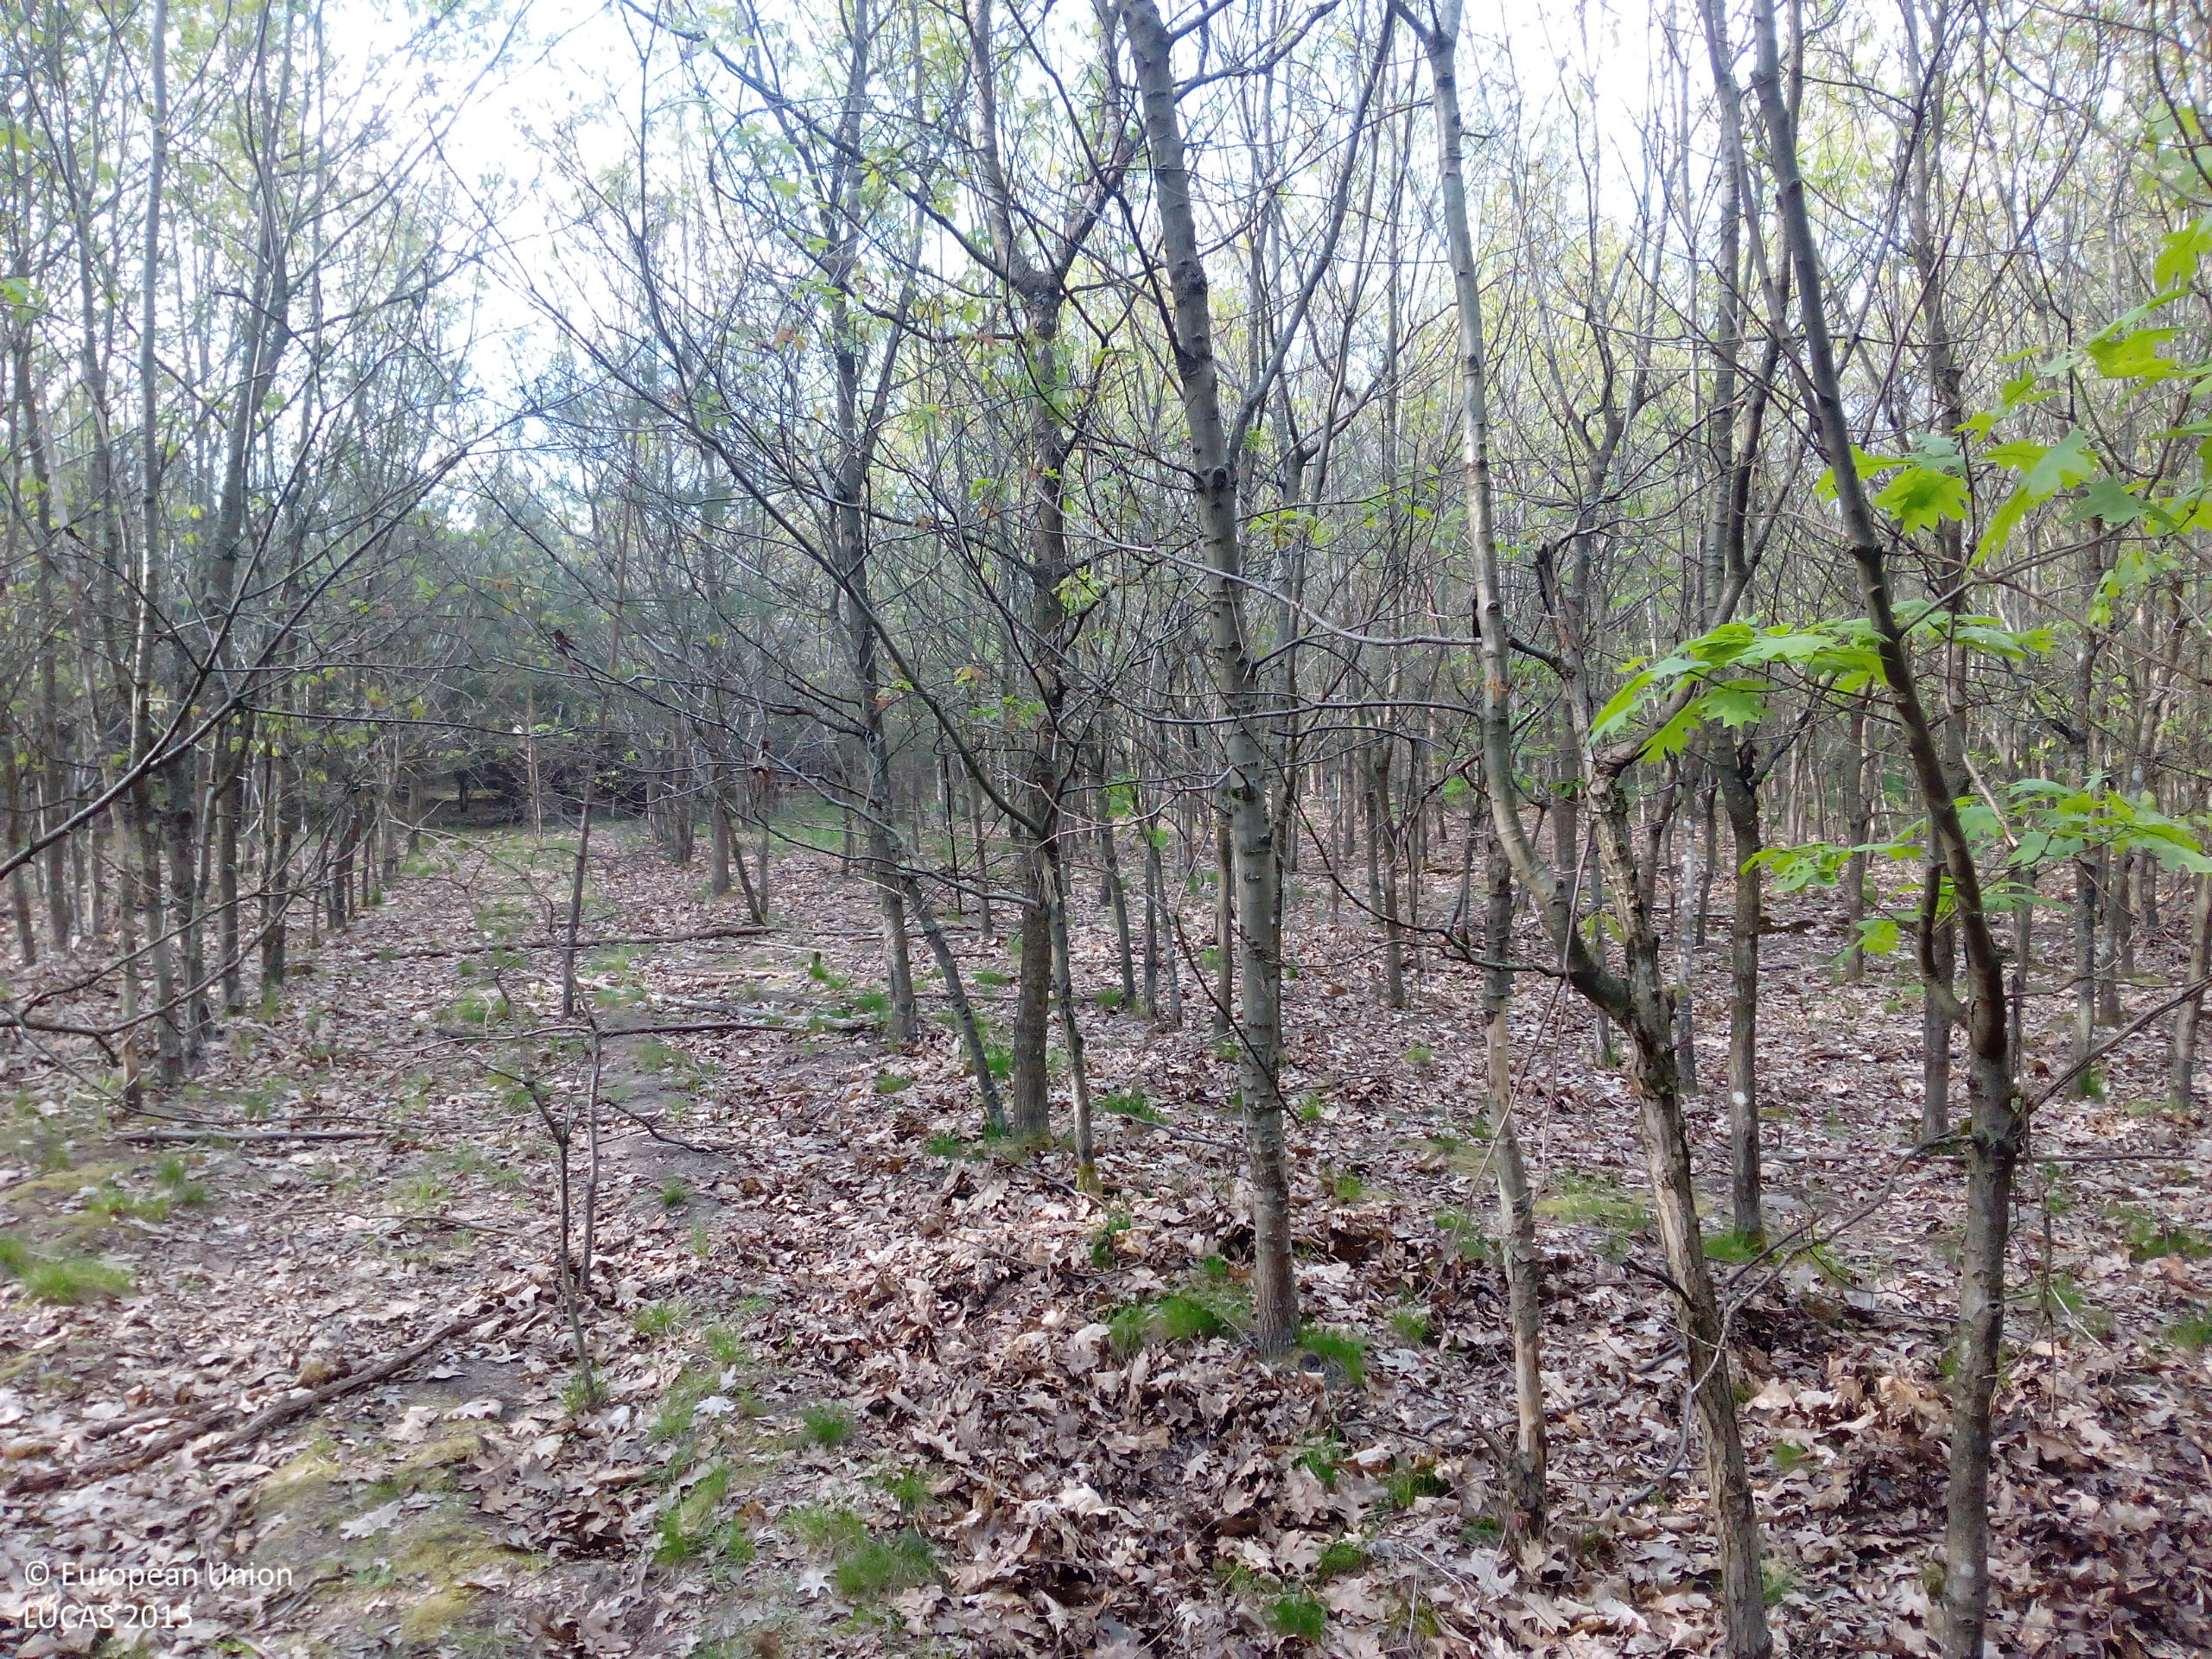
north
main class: Woodland
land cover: Broadleaved woodland
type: acidophilous oak and oak-birch forest
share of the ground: 50 - 75 %
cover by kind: broadleaved forest trees 70 %, unconsolidated bare surface 20 %, herbaceous plants 5 %, lichens and mosses 5 %
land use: Forestry
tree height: > 5 m
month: May
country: DE
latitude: 49.6354
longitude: 8.5466
